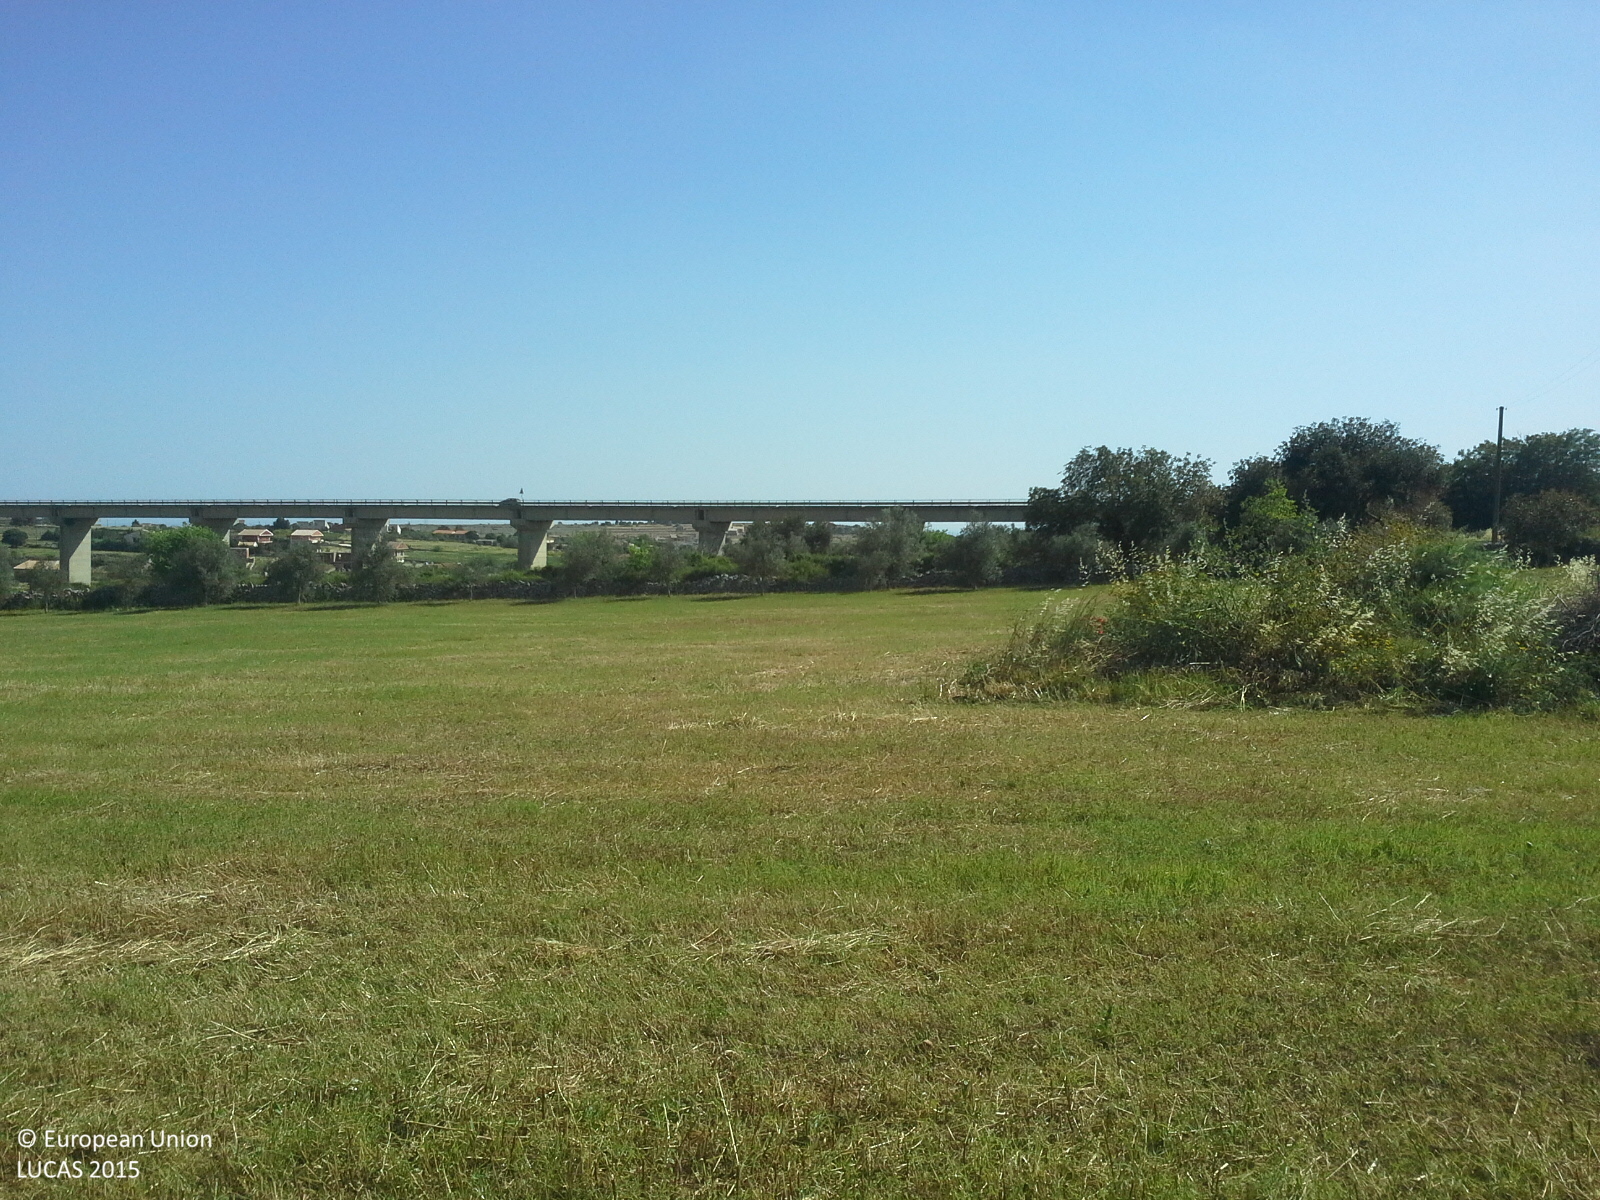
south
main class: Cropland
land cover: Olive groves
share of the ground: > 75 %
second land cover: Spontaneously vegetated surfaces
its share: > 75 %
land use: Agriculture (excluding fallow land and kitchen gardens)
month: May
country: IT
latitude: 36.8274
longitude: 14.7715
